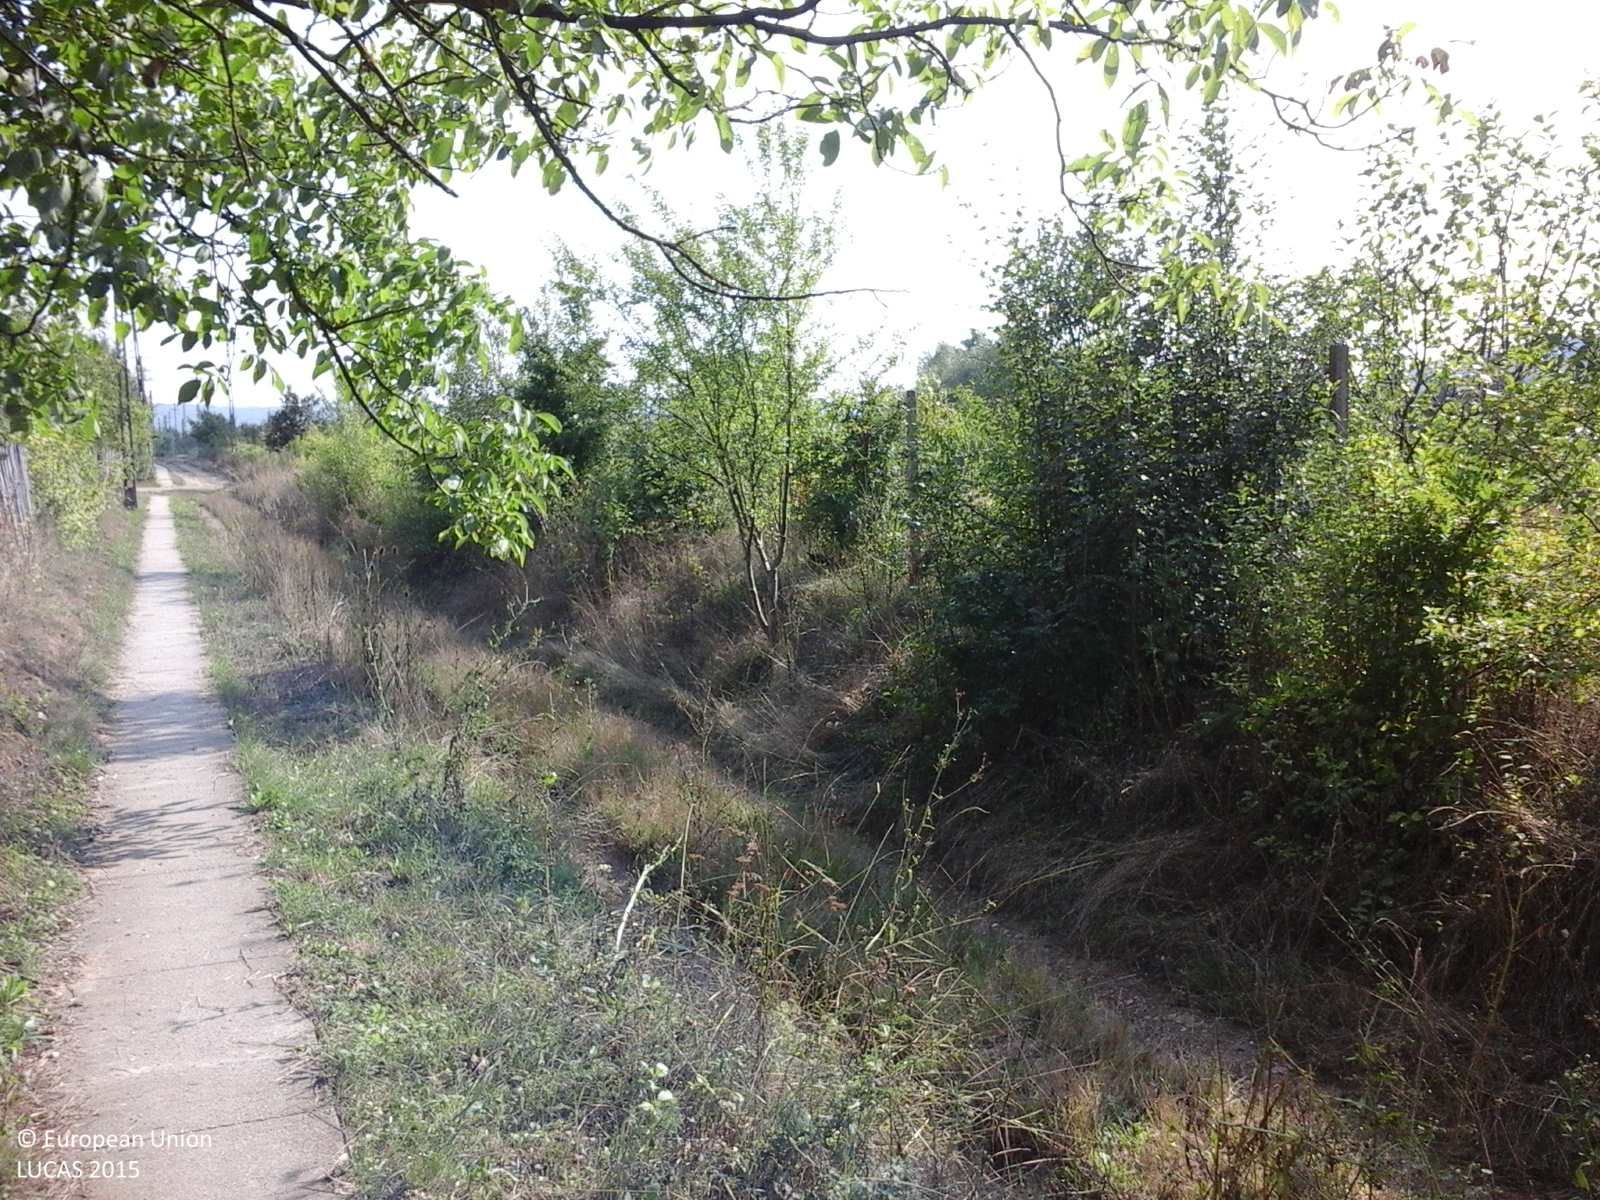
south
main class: Cropland
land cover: Maize
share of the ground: > 75 %
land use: Agriculture (excluding fallow land and kitchen gardens)
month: August
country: RO
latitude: 46.1110
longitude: 21.8267
